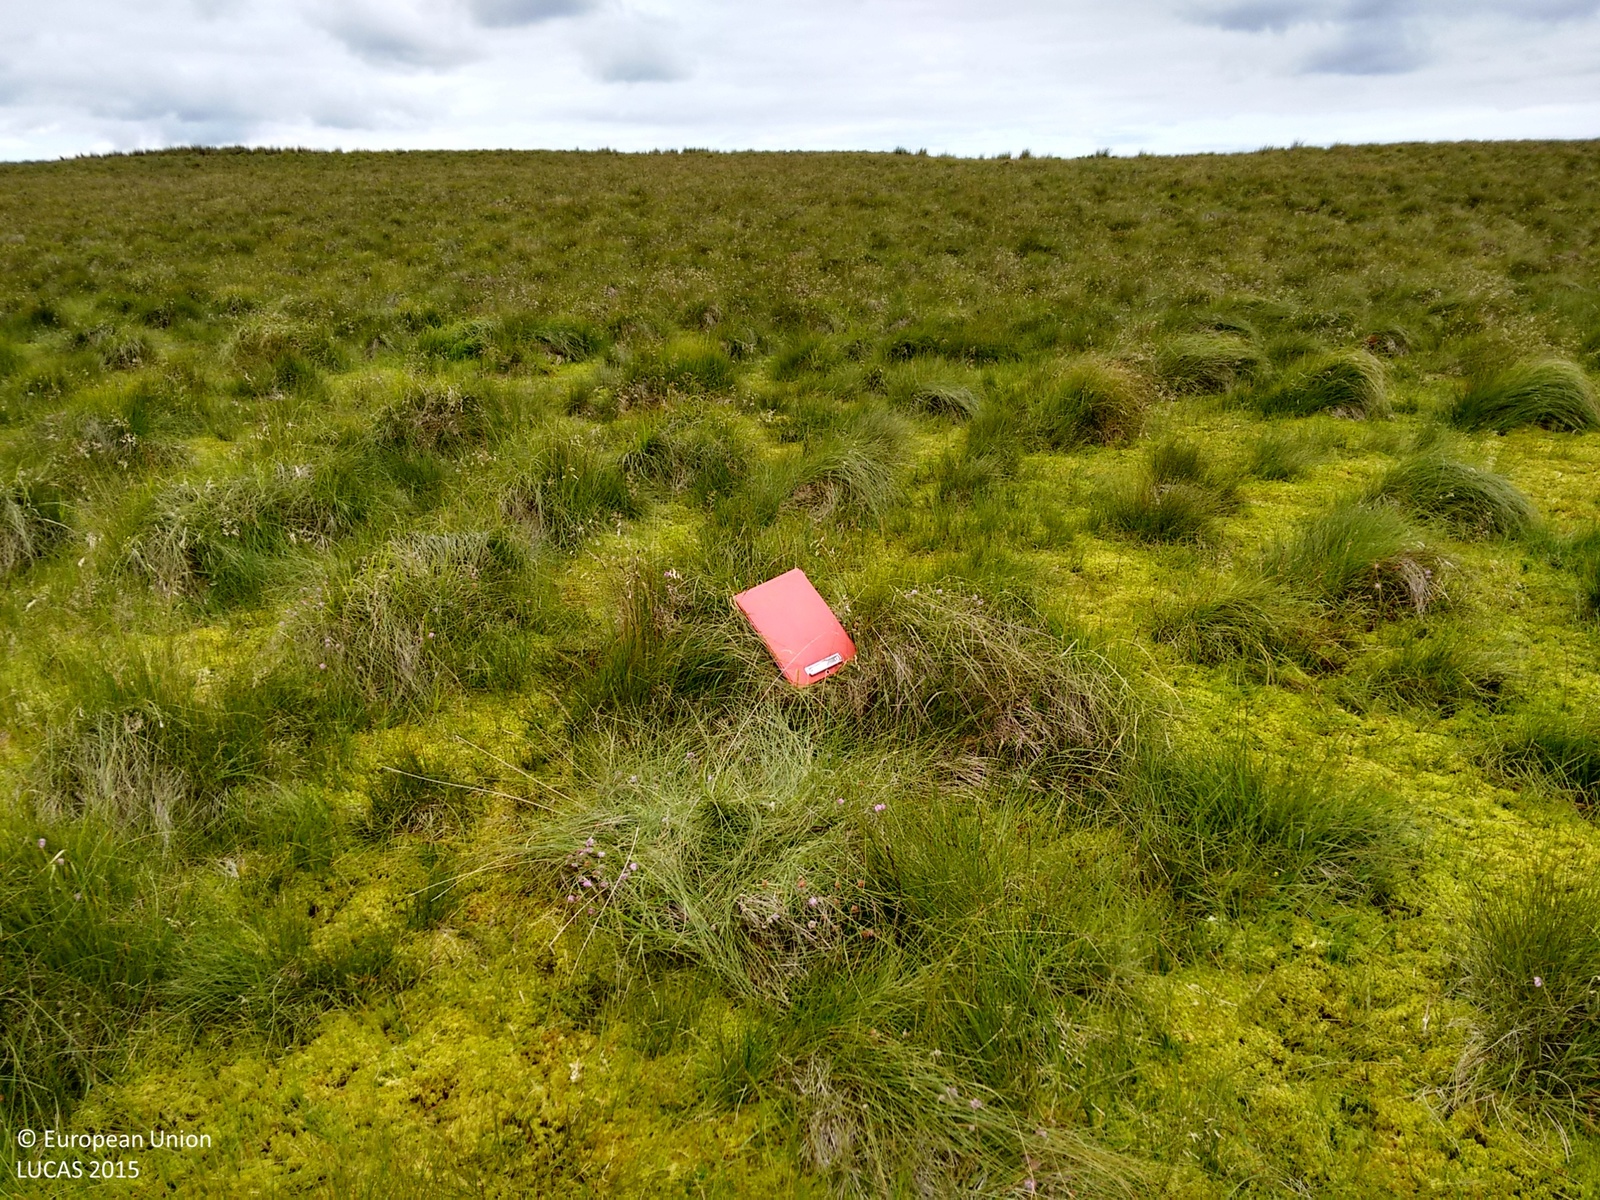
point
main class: Grassland
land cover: Grassland without tree/shrub cover
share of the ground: > 75 %
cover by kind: herbaceous plants 70 %, lichens and mosses 30 %
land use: Agriculture (excluding fallow land and kitchen gardens)
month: August
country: GB
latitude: 55.0012
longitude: -4.8843
